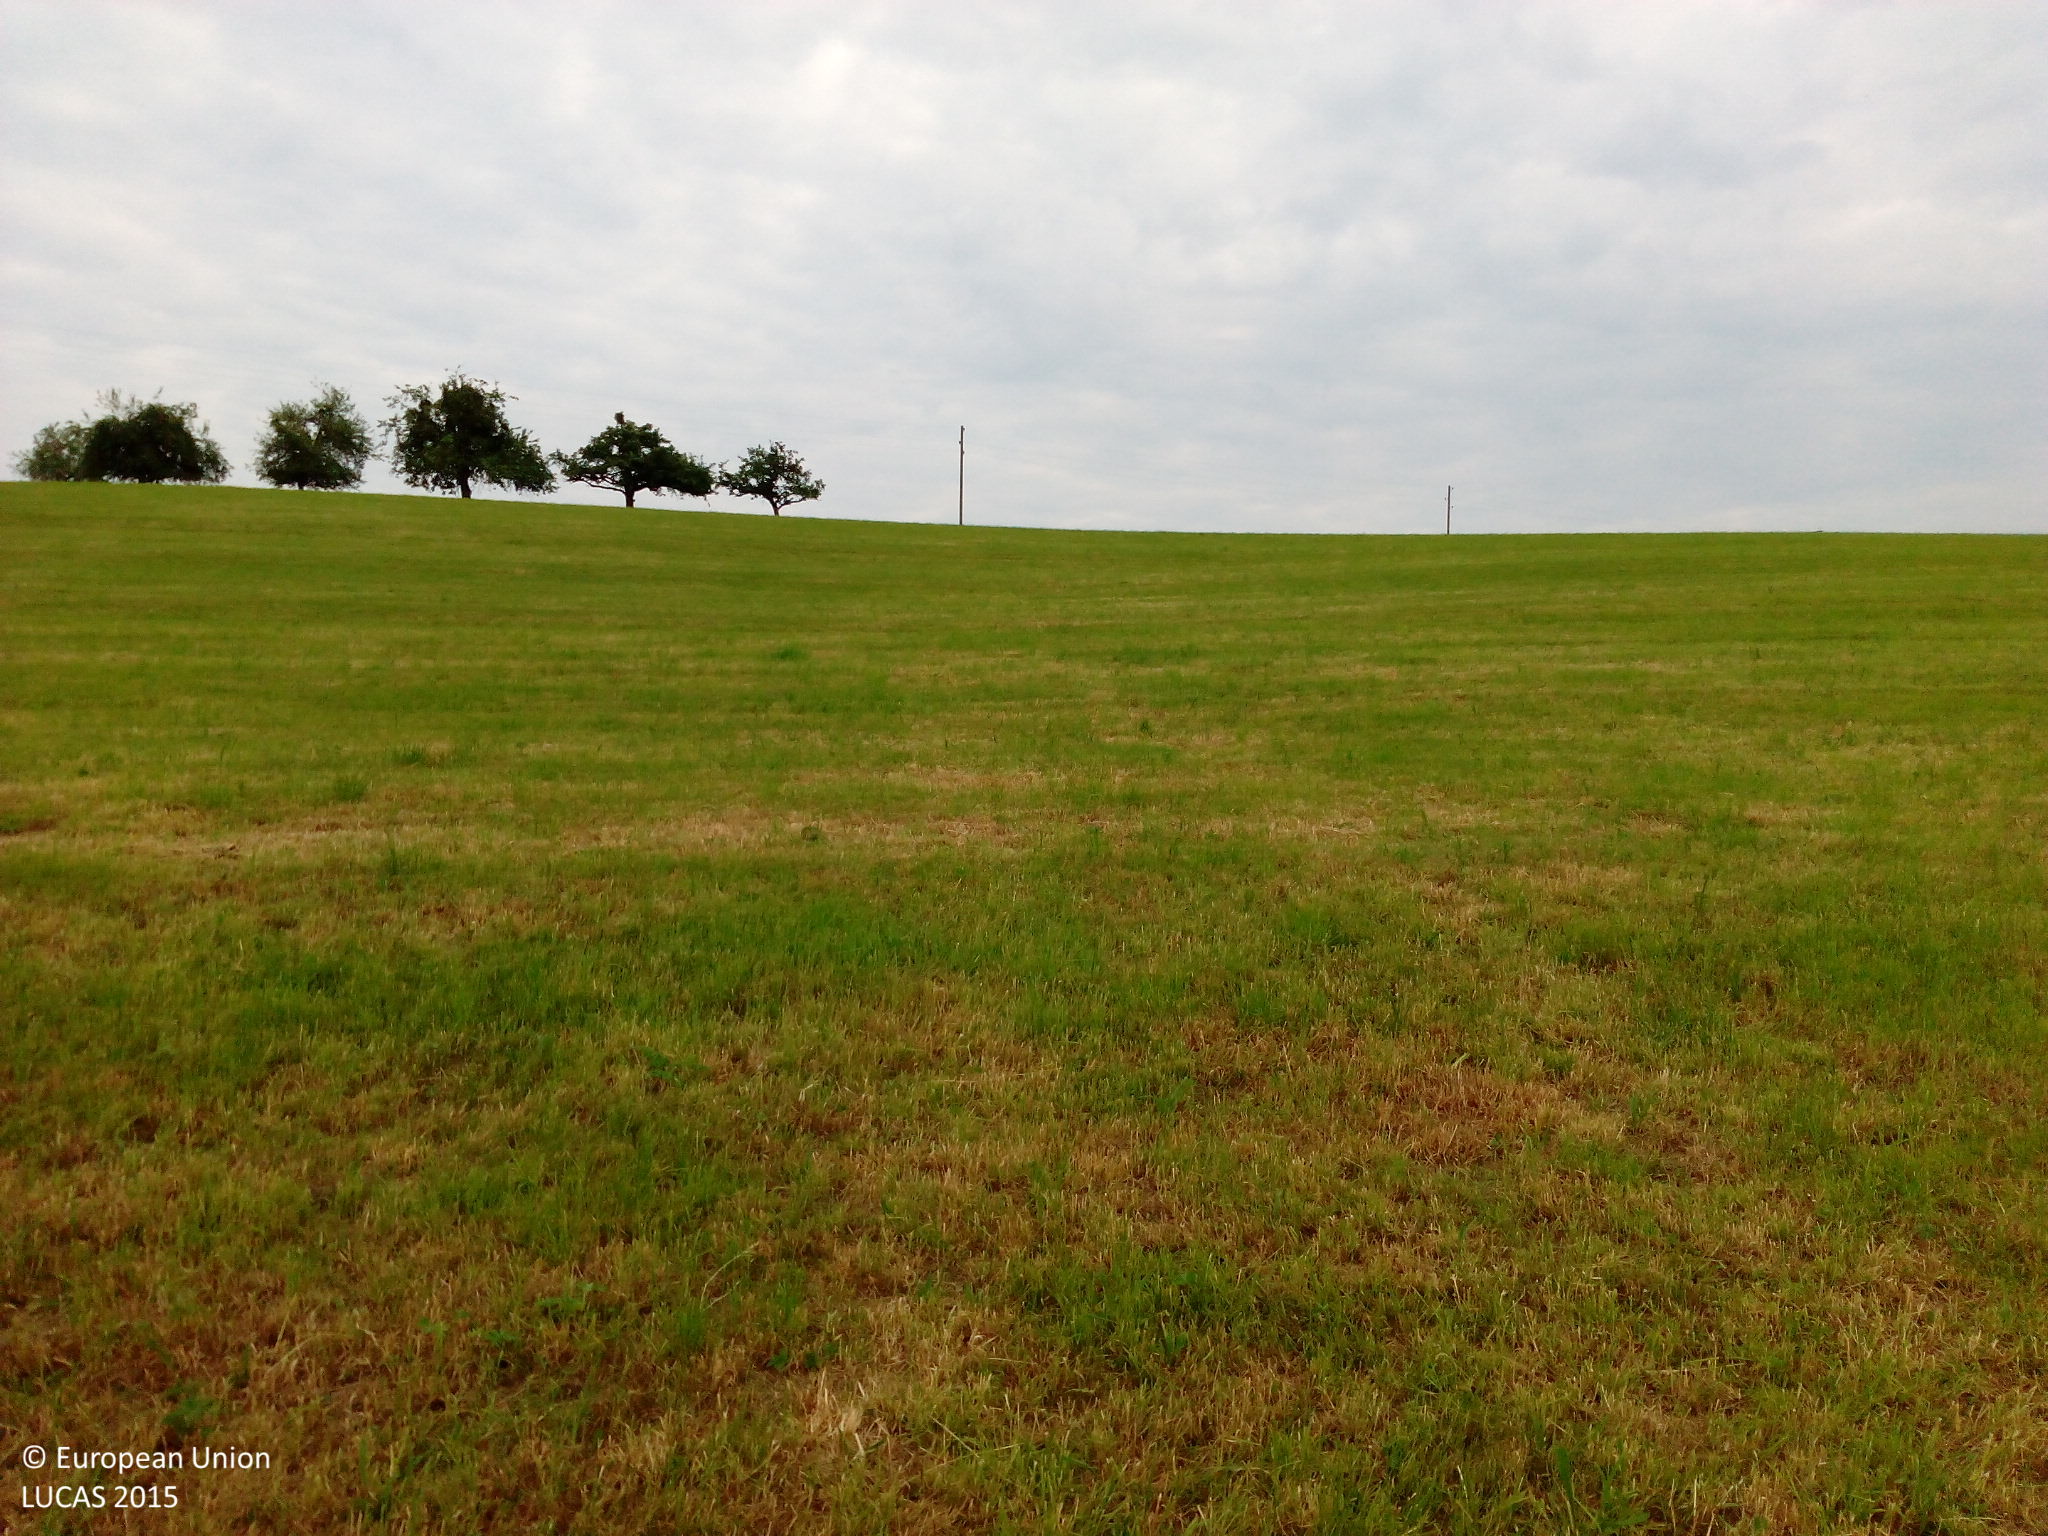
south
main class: Grassland
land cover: Grassland without tree/shrub cover
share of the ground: > 75 %
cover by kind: herbaceous plants 100 %
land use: Agriculture (excluding fallow land and kitchen gardens)
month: May
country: DE
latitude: 49.2843
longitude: 9.6015
